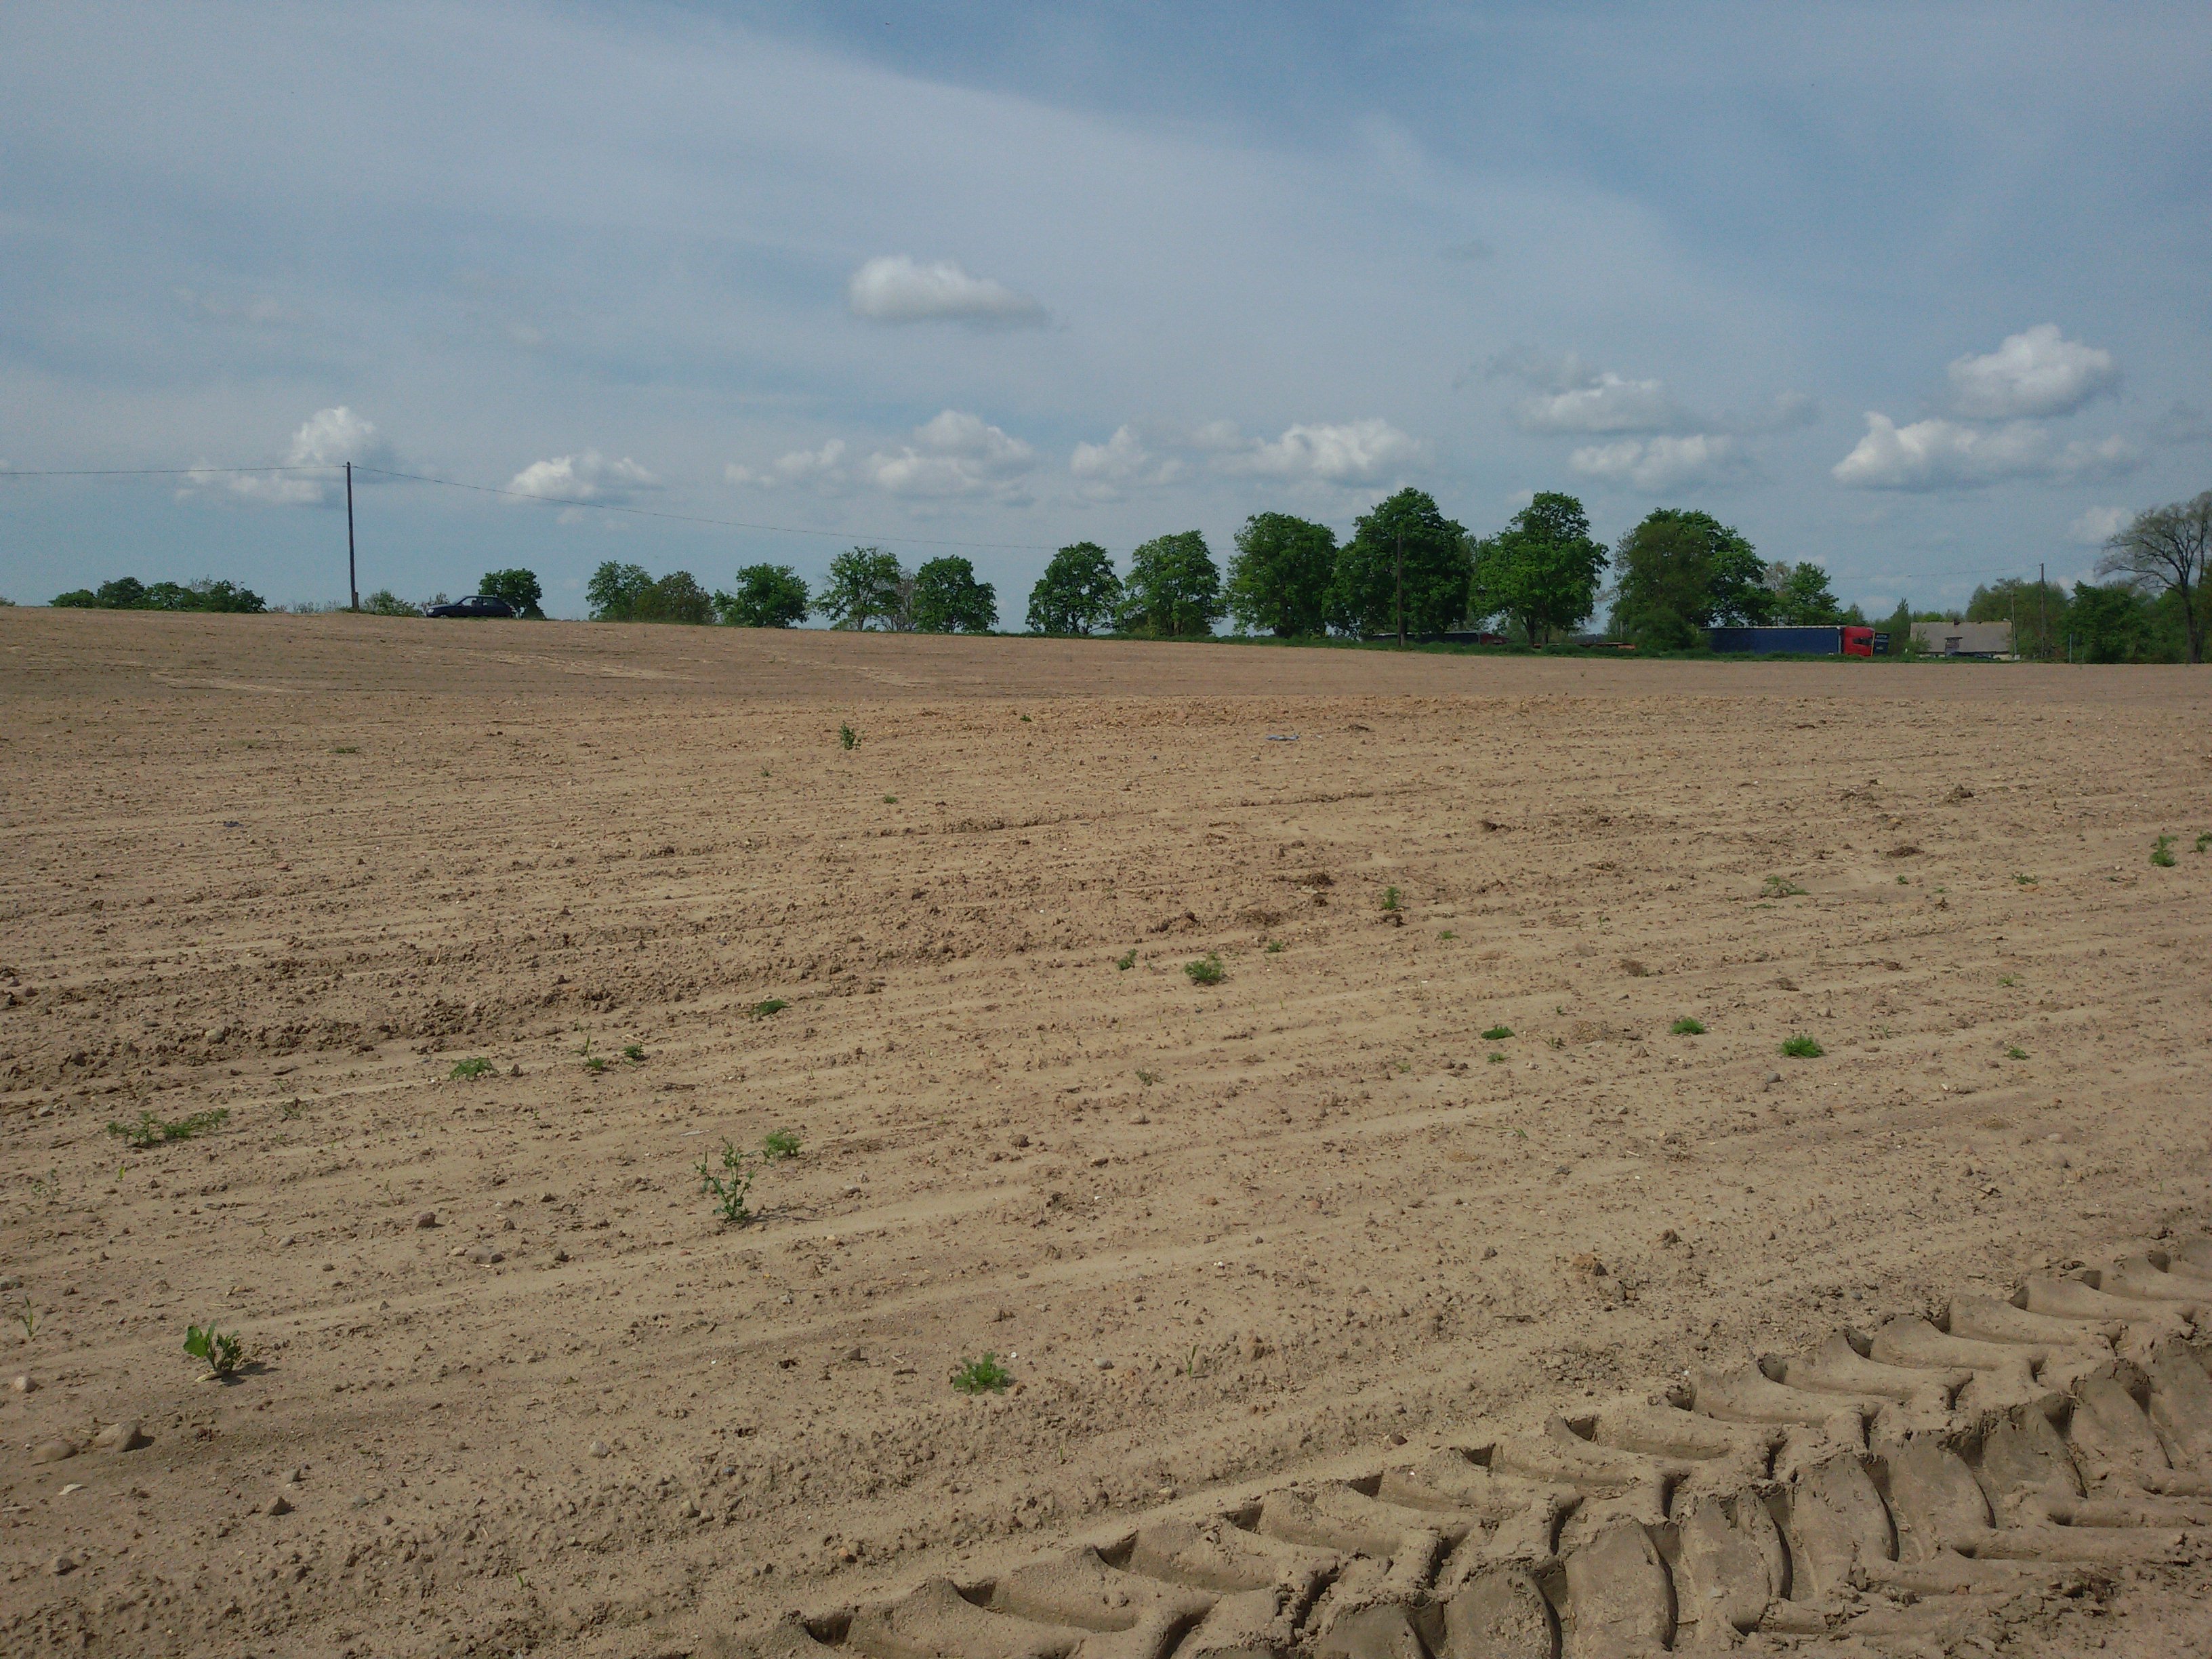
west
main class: Cropland
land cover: Common wheat
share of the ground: < 10 %
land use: Agriculture (excluding fallow land and kitchen gardens)
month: May
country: PL
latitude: 52.4841
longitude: 16.2353
